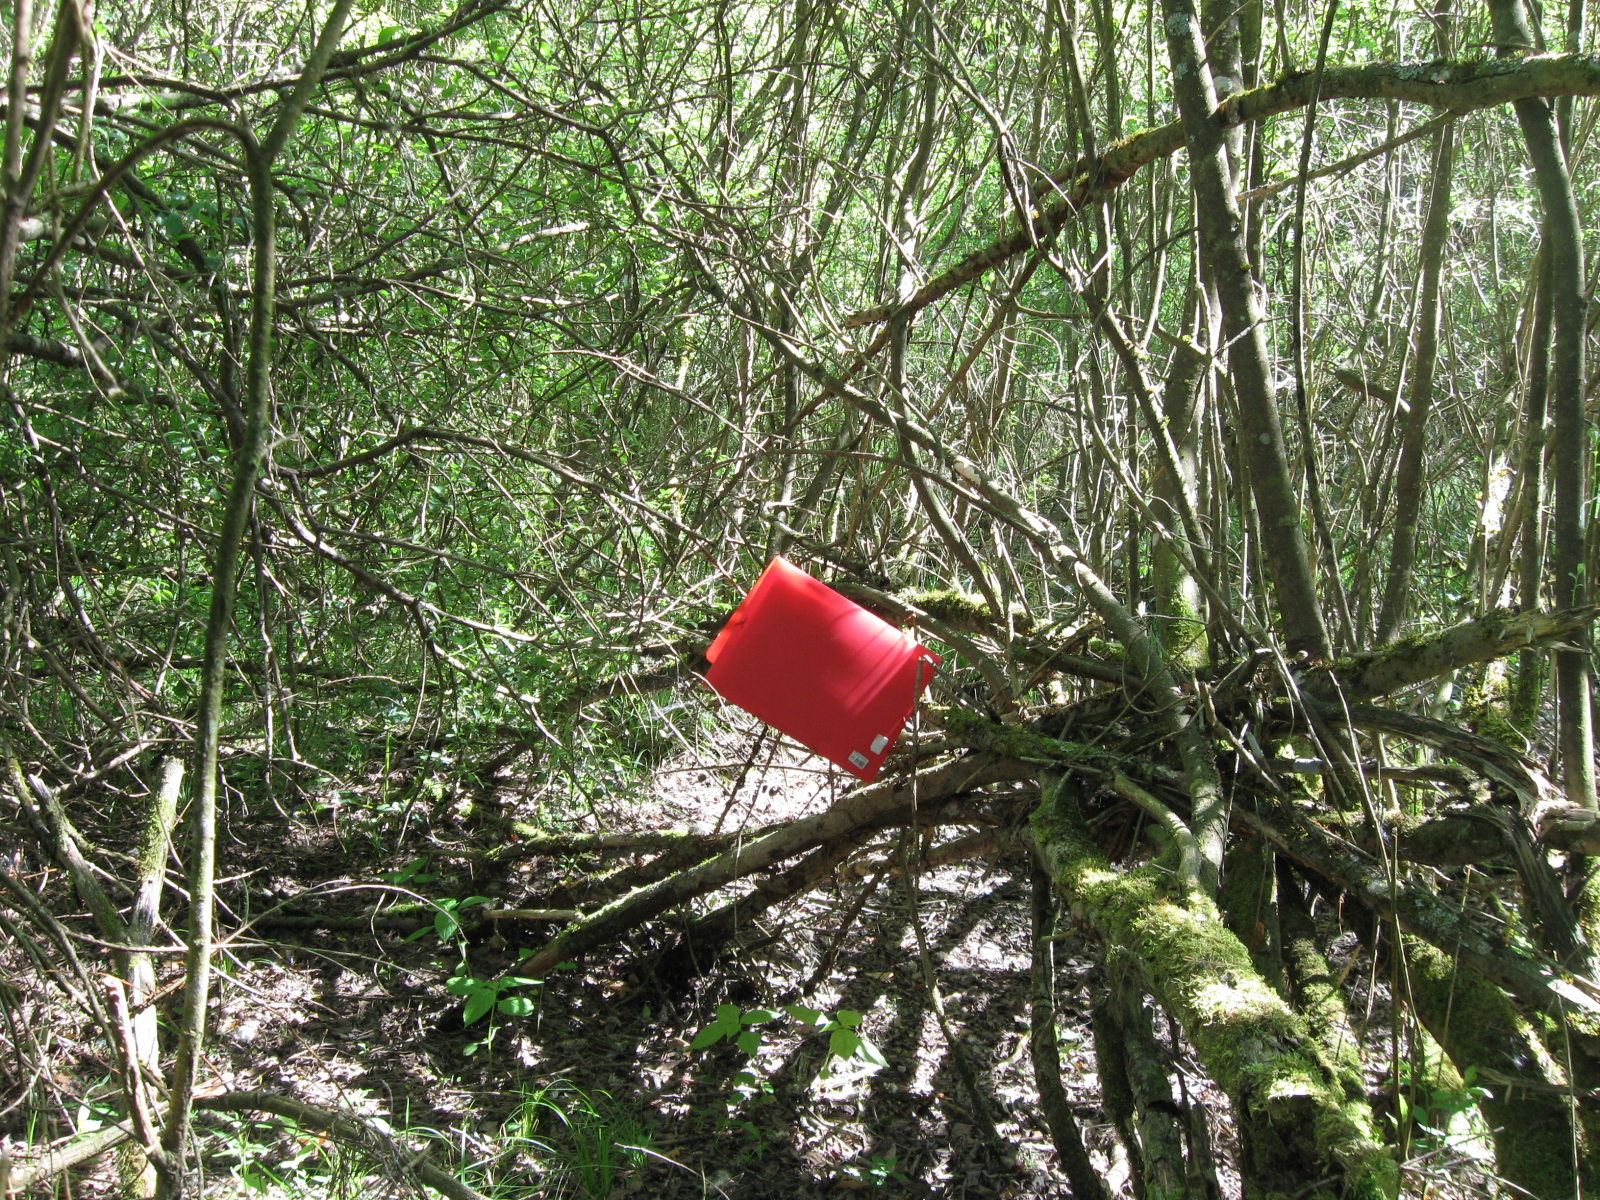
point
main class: Woodland
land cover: Spruce dominated mixed woodland
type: hemiboreal forest and nemoral coniferous forest and mixed broadleaved-coniferous forest
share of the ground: > 75 %
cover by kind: broadleaved forest trees 65 %, coniferous forest trees 30 %, herbaceous plants 5 %
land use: Forestry
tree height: > 5 m
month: June
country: LT
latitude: 54.1058
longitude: 23.6207
